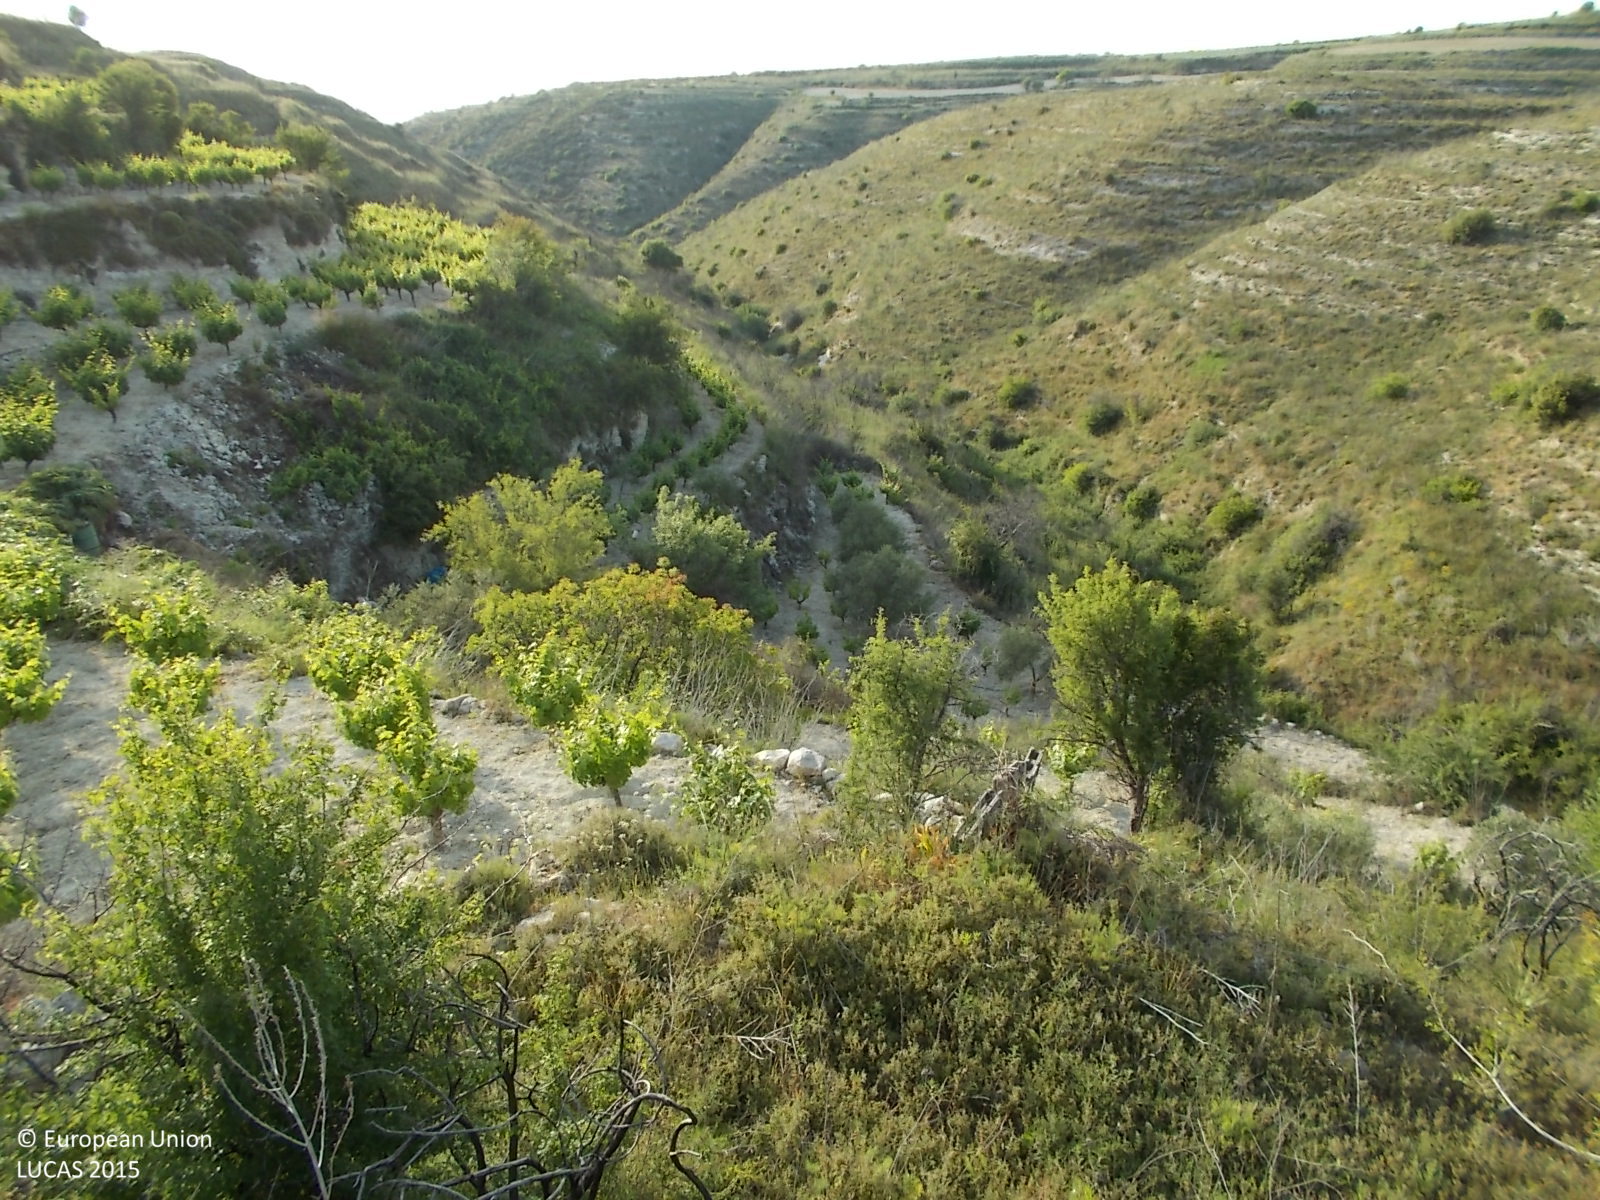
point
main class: Cropland
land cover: Vineyards
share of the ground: 25 - 50 %
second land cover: Other bare soil
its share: > 75 %
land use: Agriculture (excluding fallow land and kitchen gardens)
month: May
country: CY
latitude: 34.9082
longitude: 32.3984
